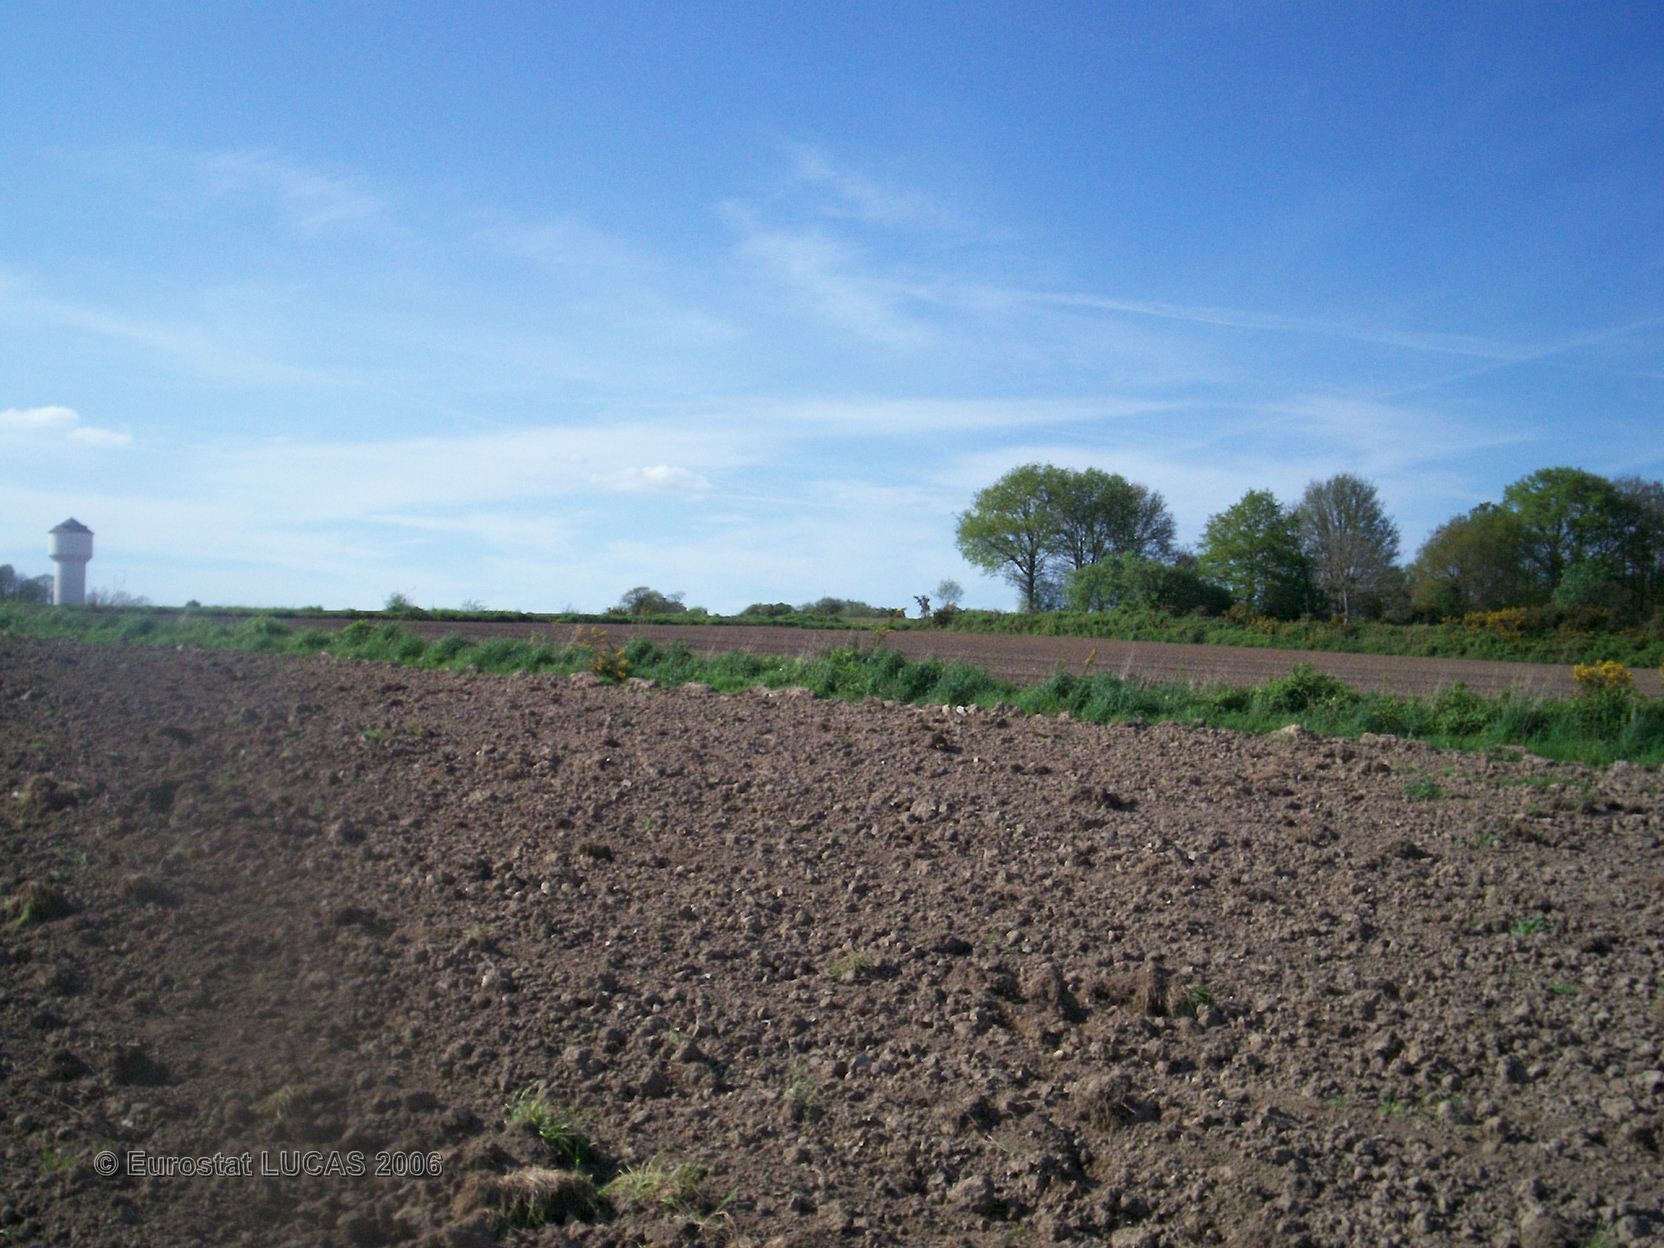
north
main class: Cropland
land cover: Maize
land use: Agriculture (excluding fallow land and kitchen gardens)
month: May
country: FR
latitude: 48.0059
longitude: -2.9210
